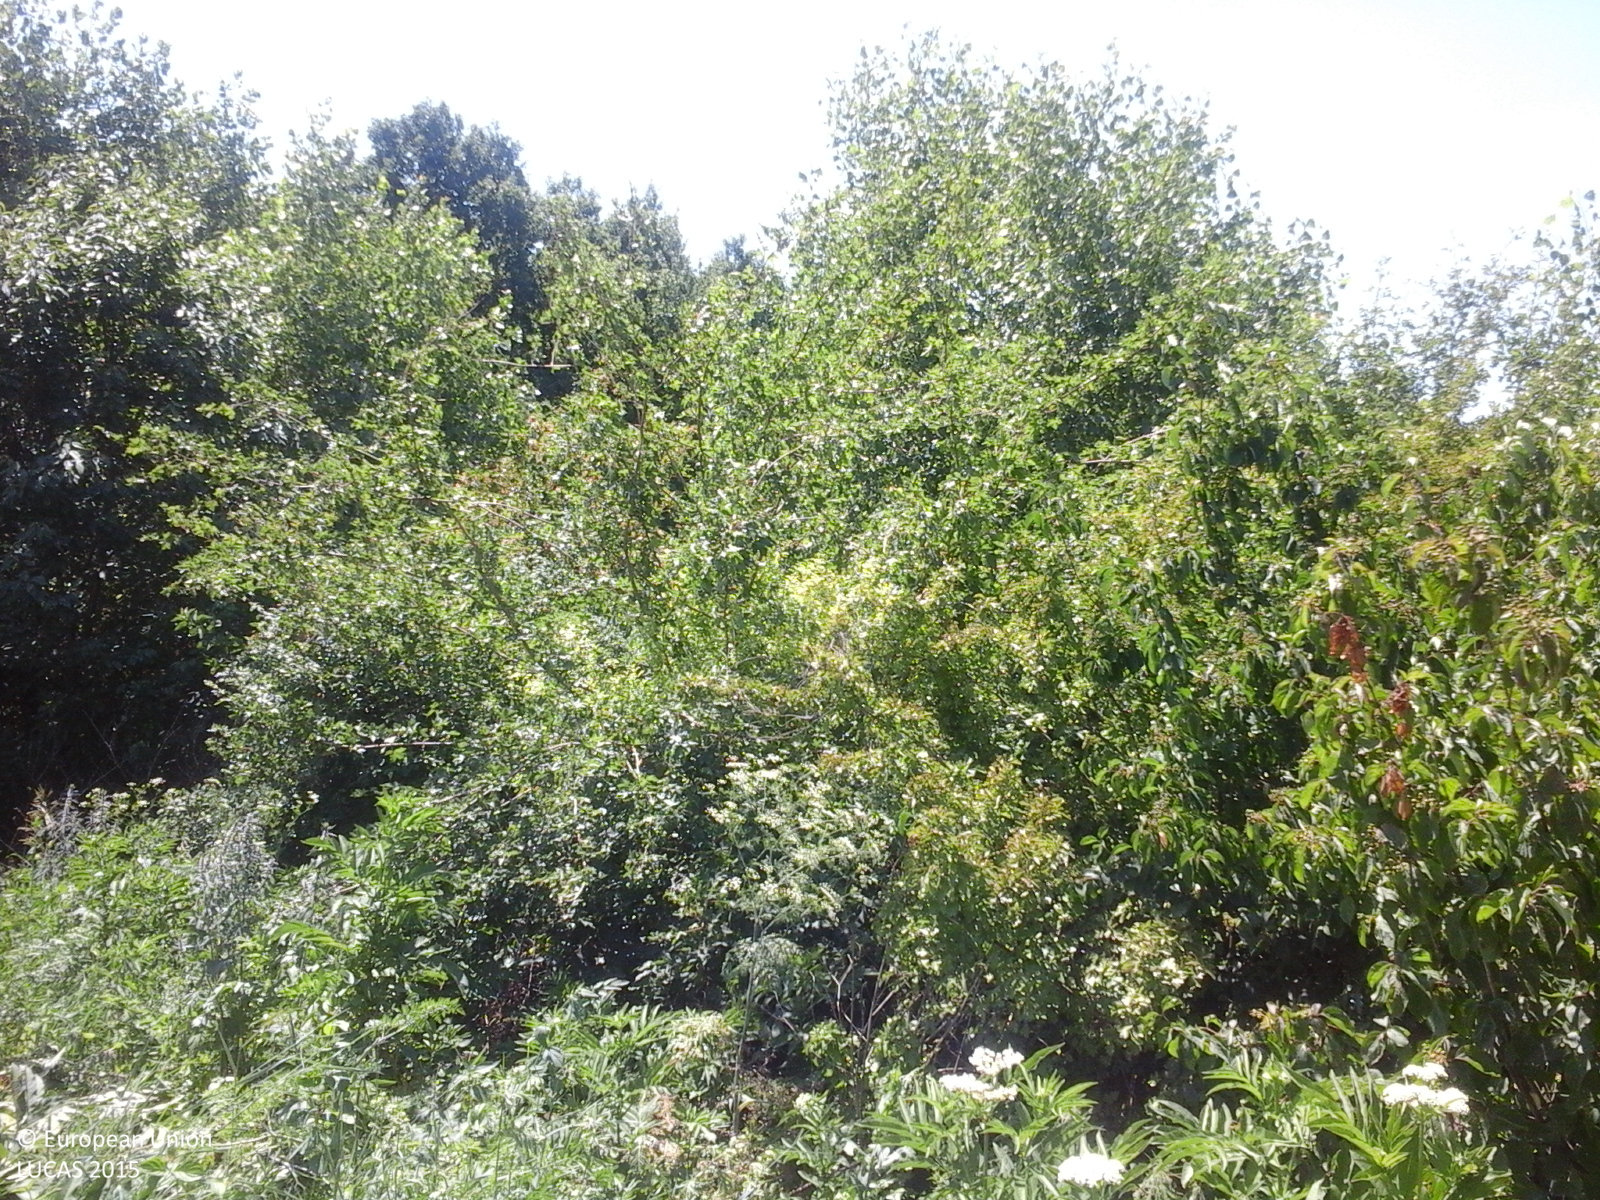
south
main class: Shrubland
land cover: Shrubland with sparse tree cover
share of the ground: > 75 %
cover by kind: shrubs 95 %, broadleaved forest trees 5 %
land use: Abandoned areas
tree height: > 5 m
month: June
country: RO
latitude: 47.7975
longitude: 27.0760
